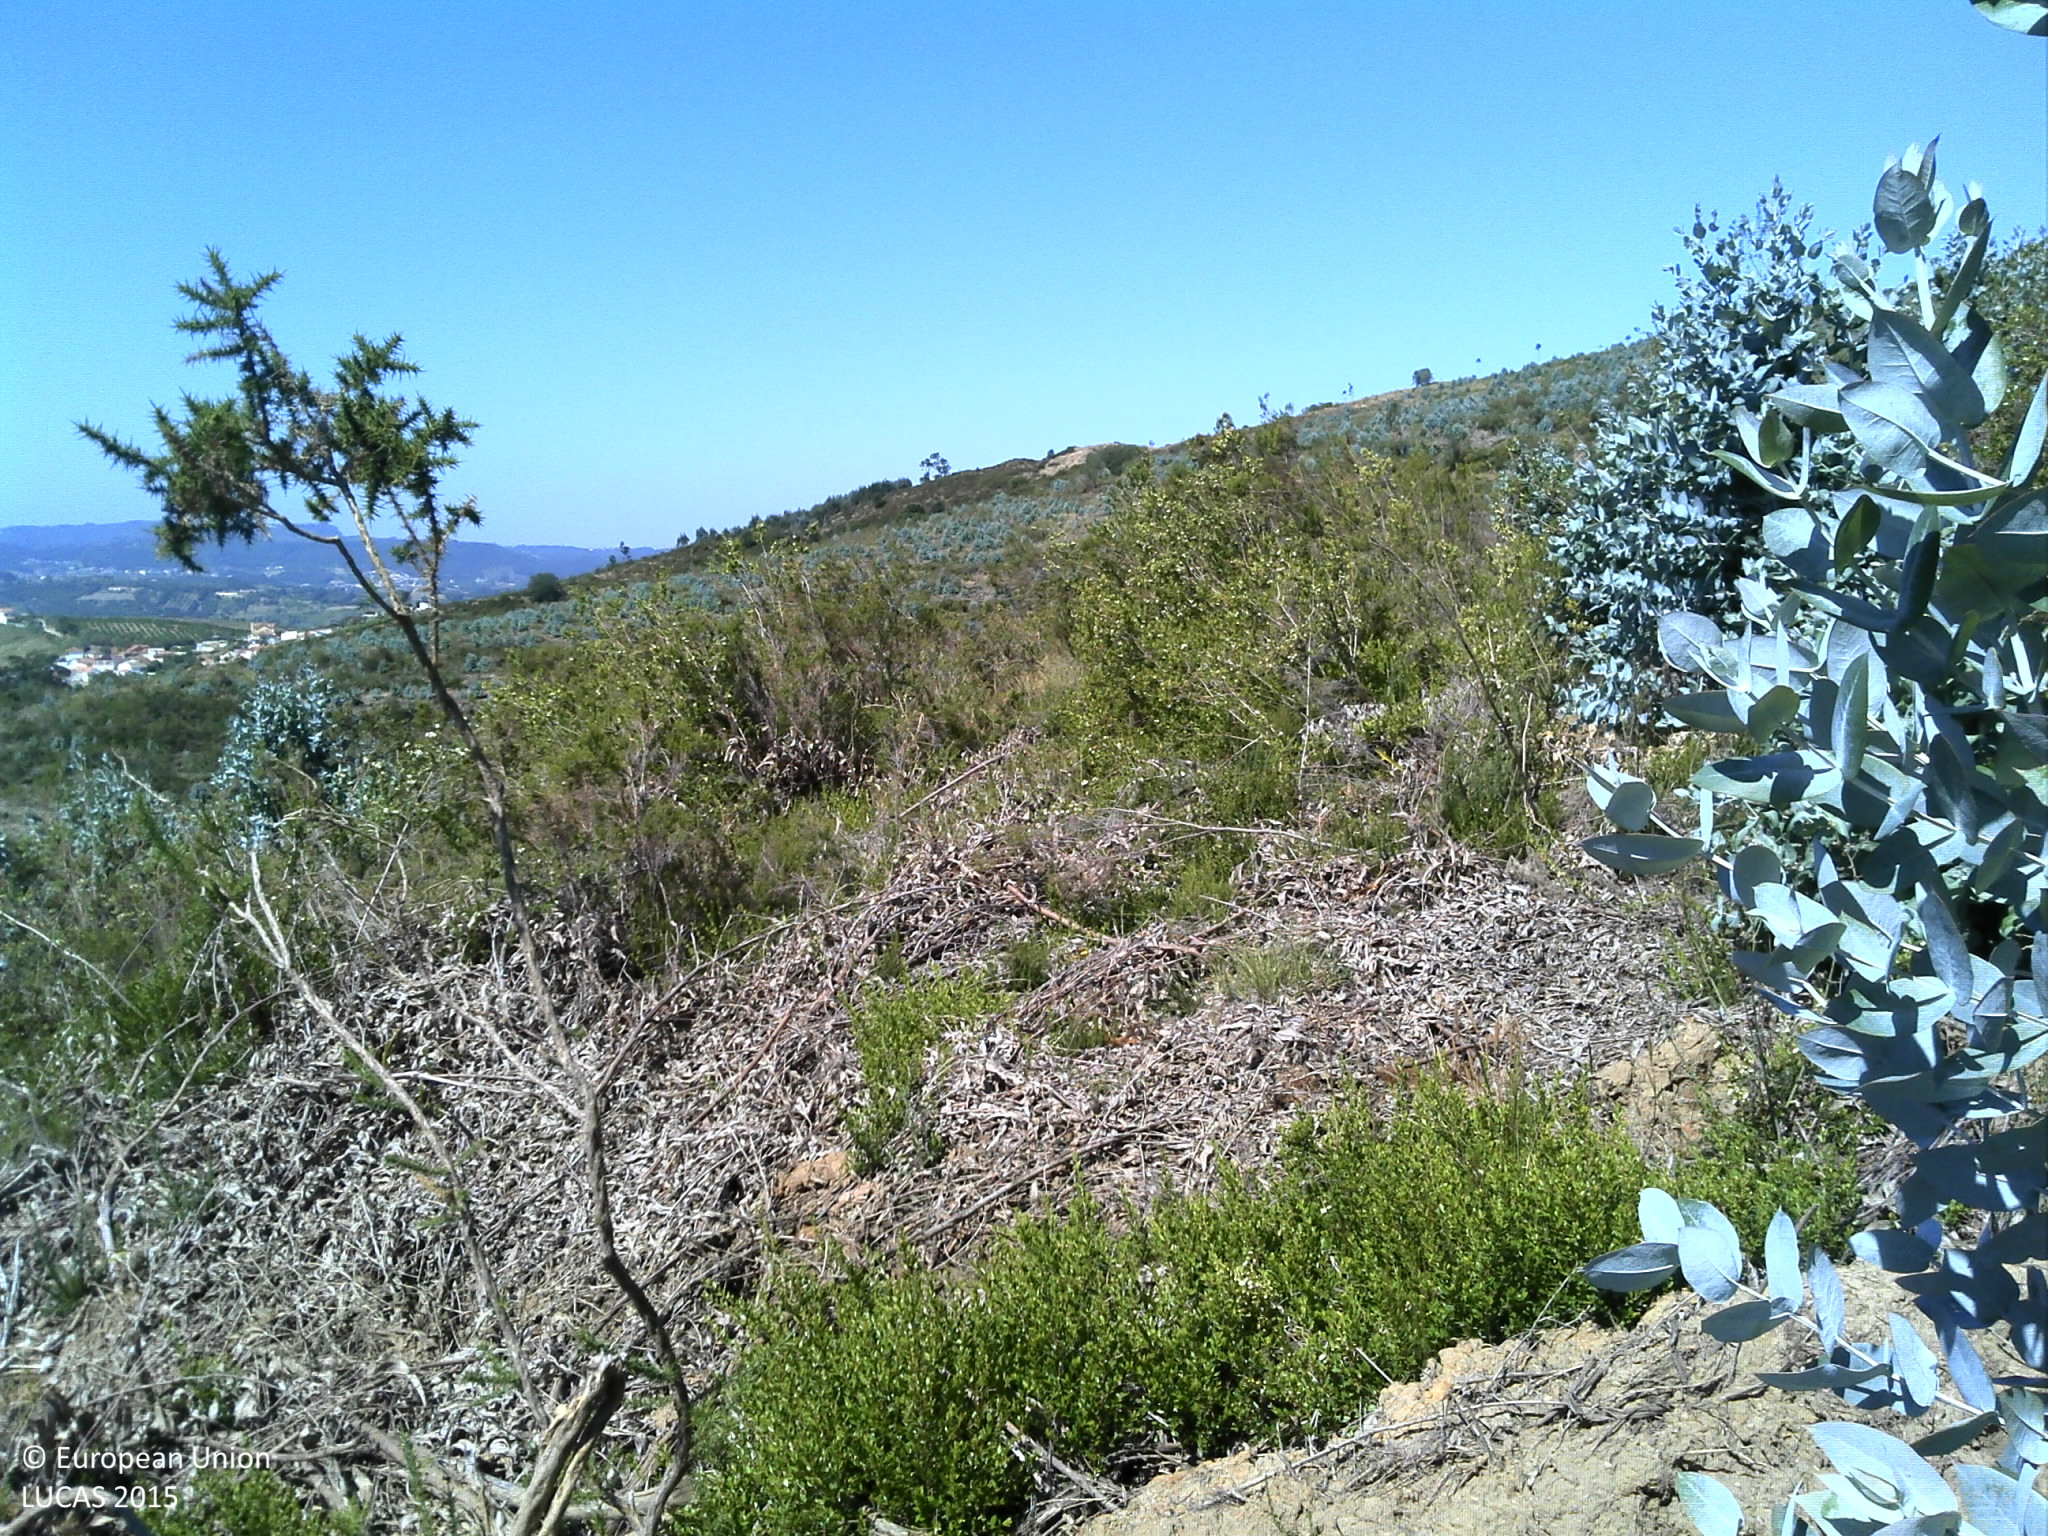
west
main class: Woodland
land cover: Broadleaved woodland
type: exotic forest
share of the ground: 10 - 25 %
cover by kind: shrubs 50 %, broadleaved forest trees 25 %, unconsolidated bare surface 25 %
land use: Forestry
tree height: < 5 m
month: June
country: PT
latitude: 39.0140
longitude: -9.2202
